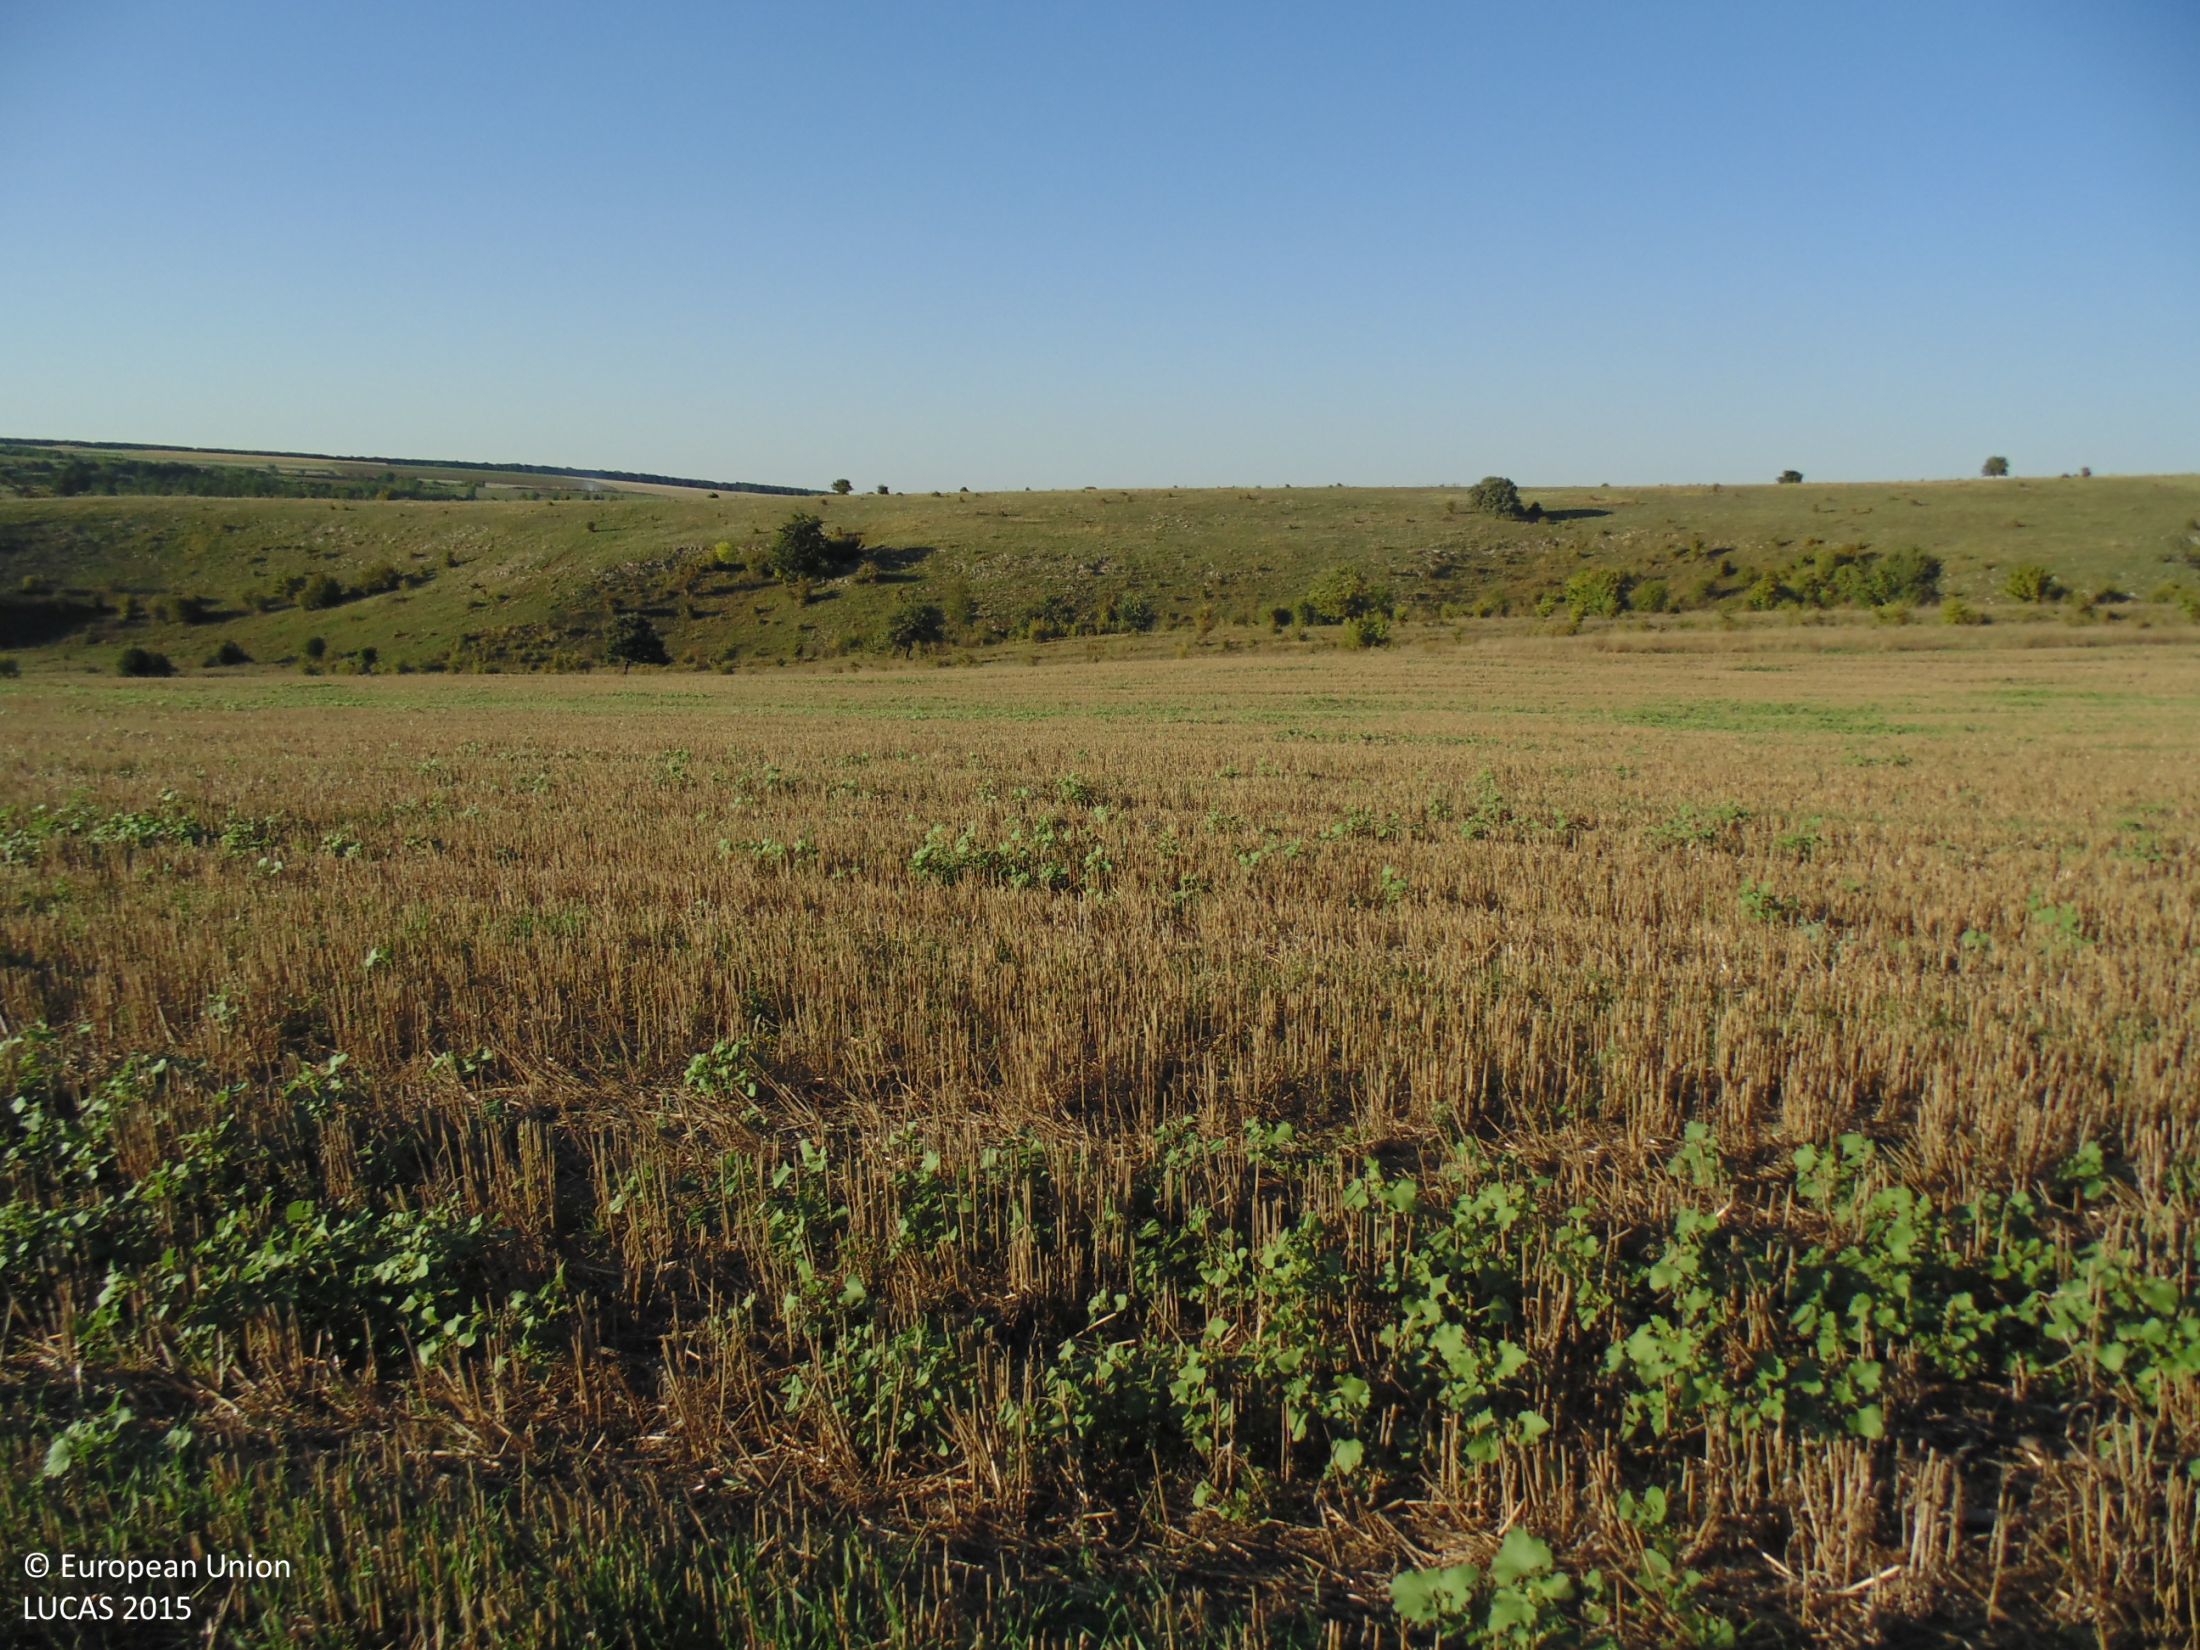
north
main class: Cropland
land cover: Common wheat
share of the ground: 25 - 50 %
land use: Agriculture (excluding fallow land and kitchen gardens)
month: September
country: BG
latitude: 43.6737
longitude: 27.2040
